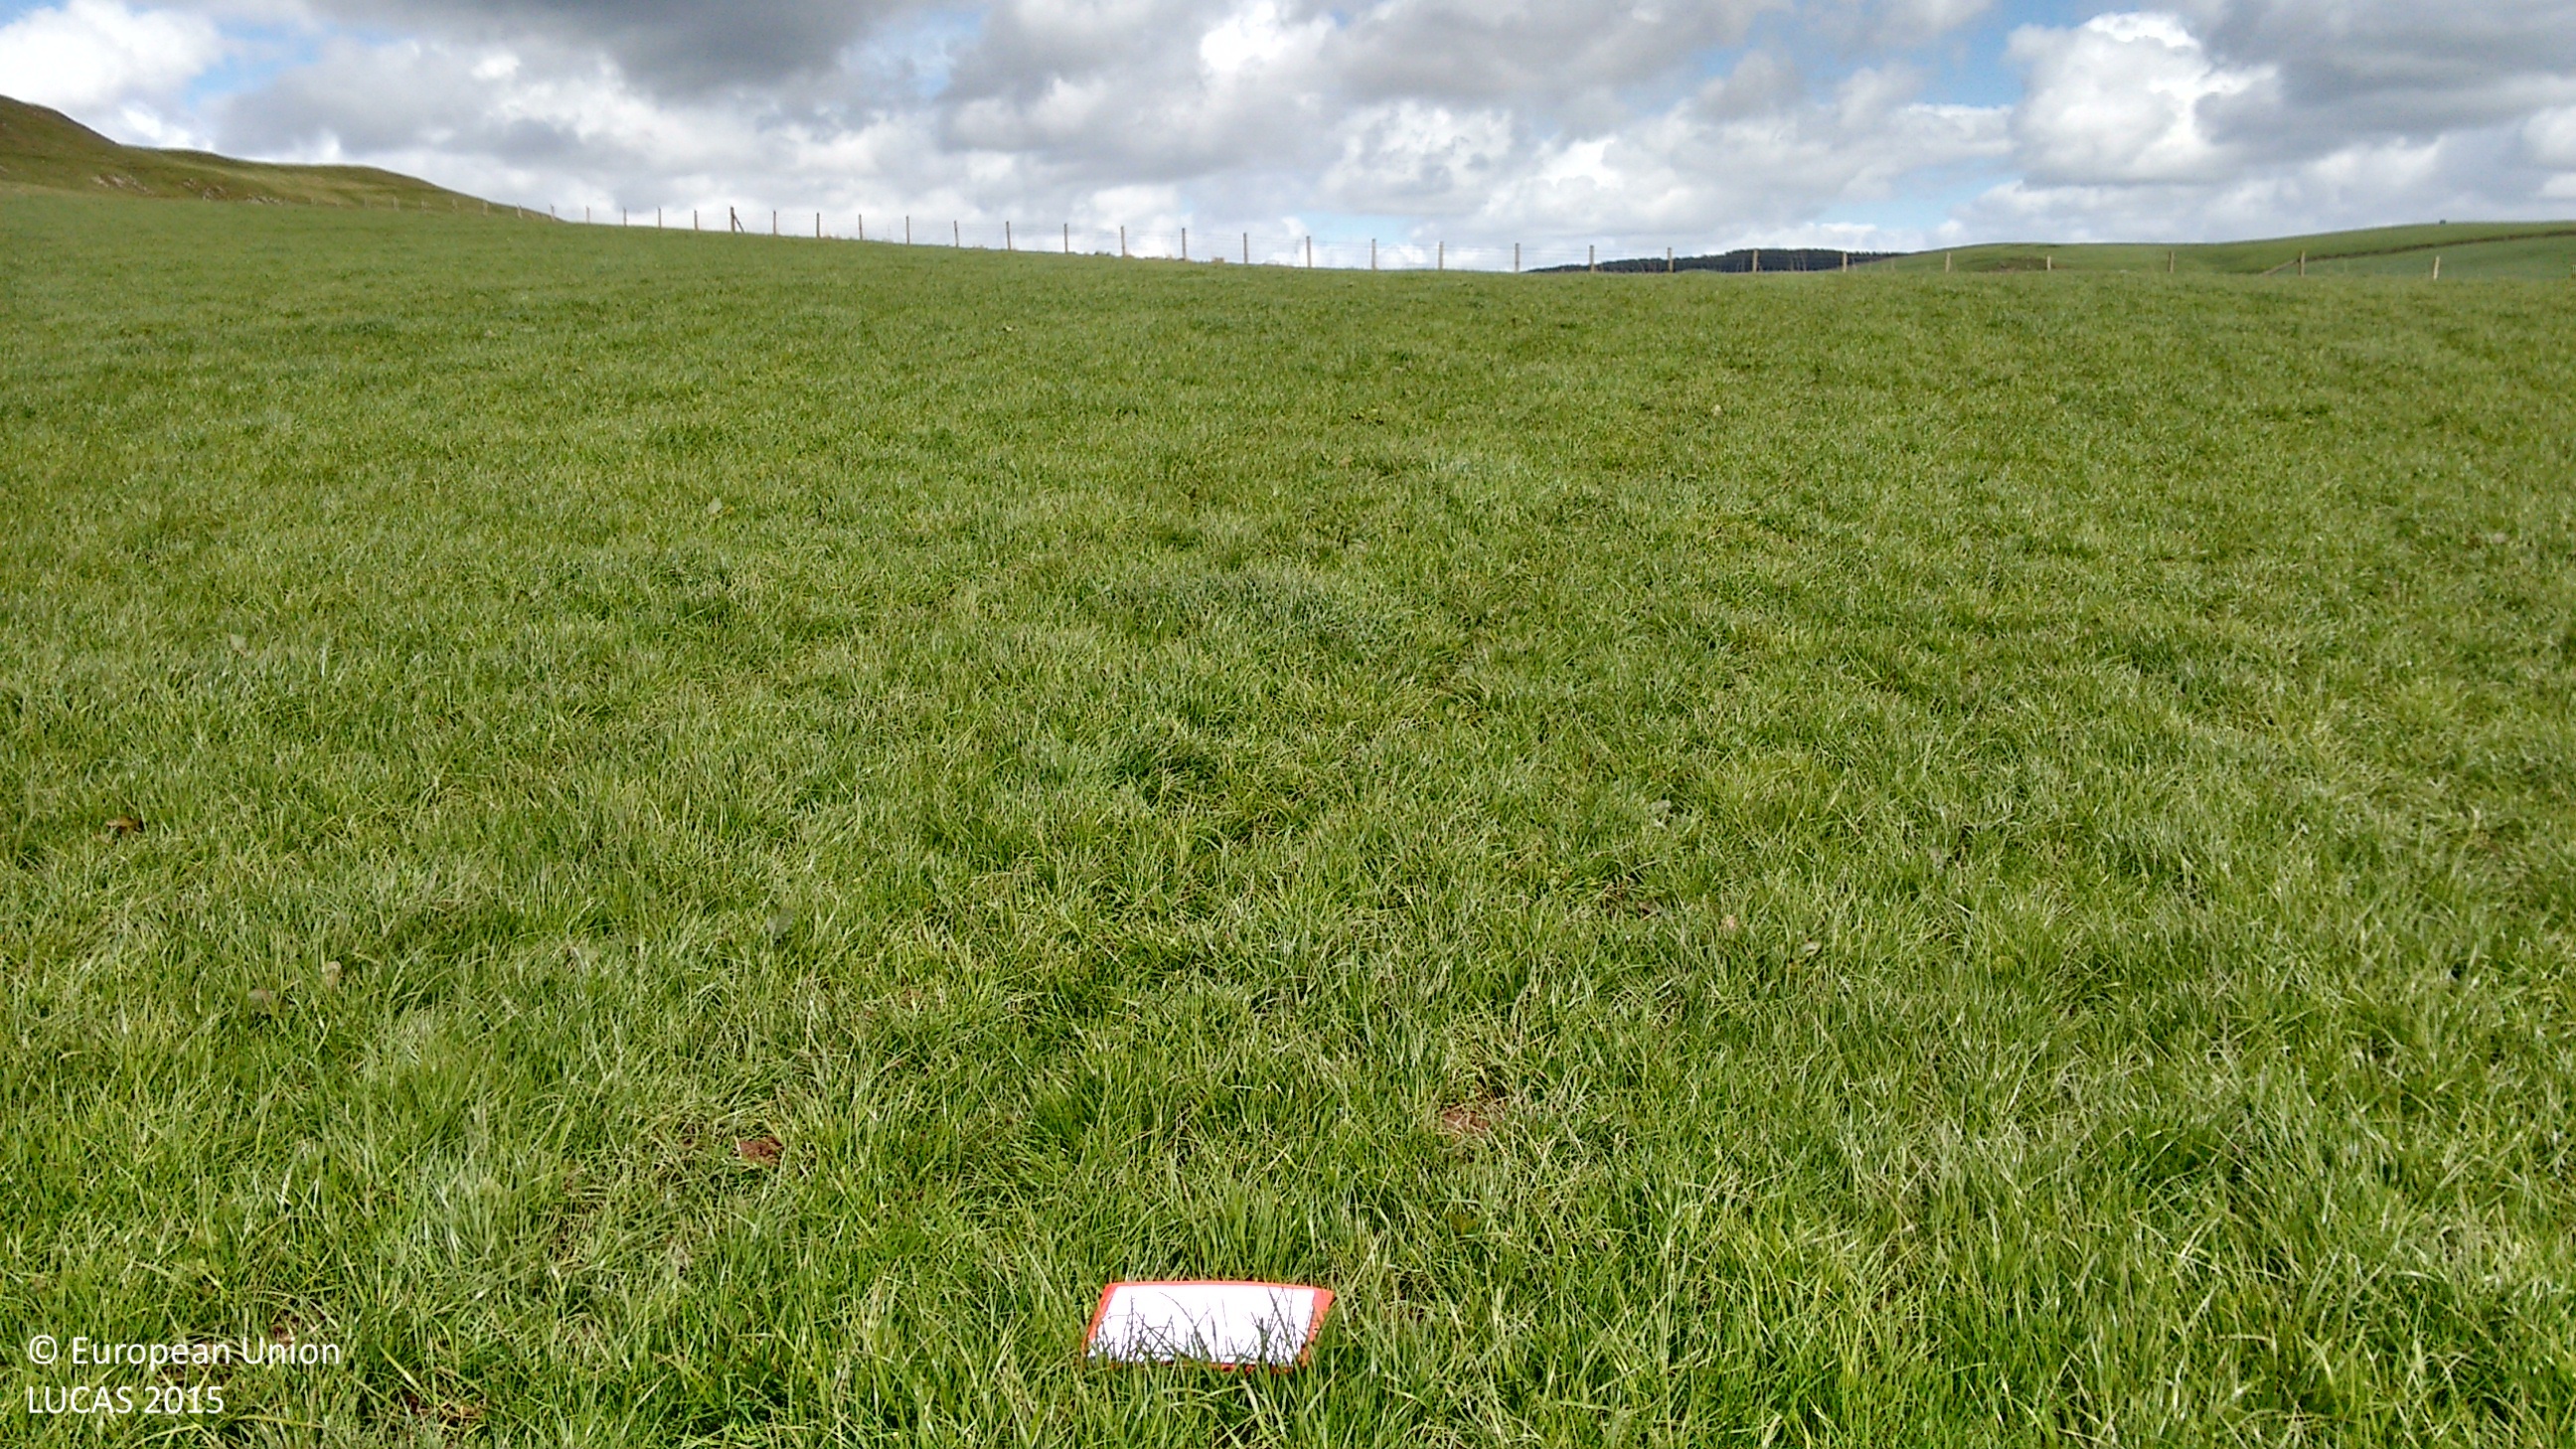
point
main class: Grassland
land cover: Grassland without tree/shrub cover
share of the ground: > 75 %
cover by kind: herbaceous plants 100 %
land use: Agriculture (excluding fallow land and kitchen gardens)
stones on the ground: < 10 %
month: April
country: GB
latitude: 53.9127
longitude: -2.5337
